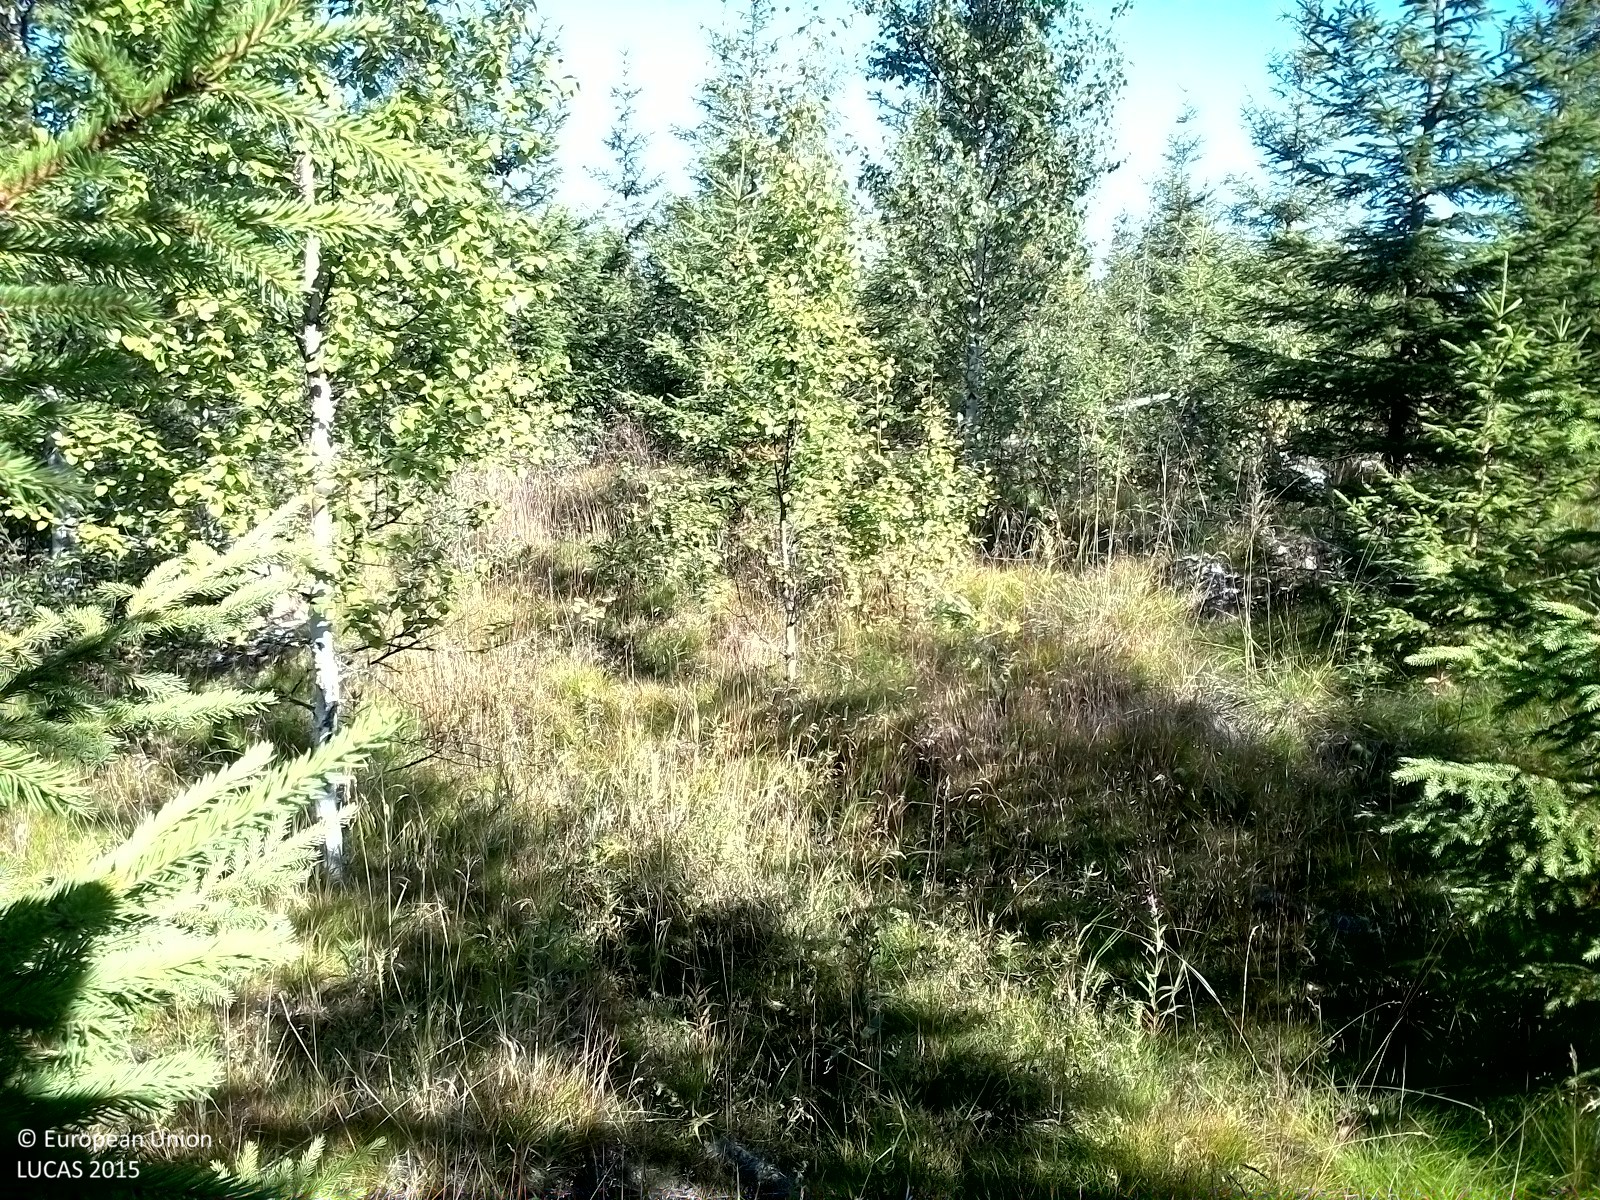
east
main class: Woodland
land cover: Spruce dominated mixed woodland
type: boreal forest
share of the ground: 50 - 75 %
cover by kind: herbaceous plants 50 %, coniferous forest trees 35 %, broadleaved forest trees 15 %
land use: Forestry
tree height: < 5 m
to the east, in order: Spruce dominated mixed woodland; Spruce dominated coniferous woodland; Spruce dominated mixed woodland
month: August
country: SE
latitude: 62.2953
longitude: 16.4006
